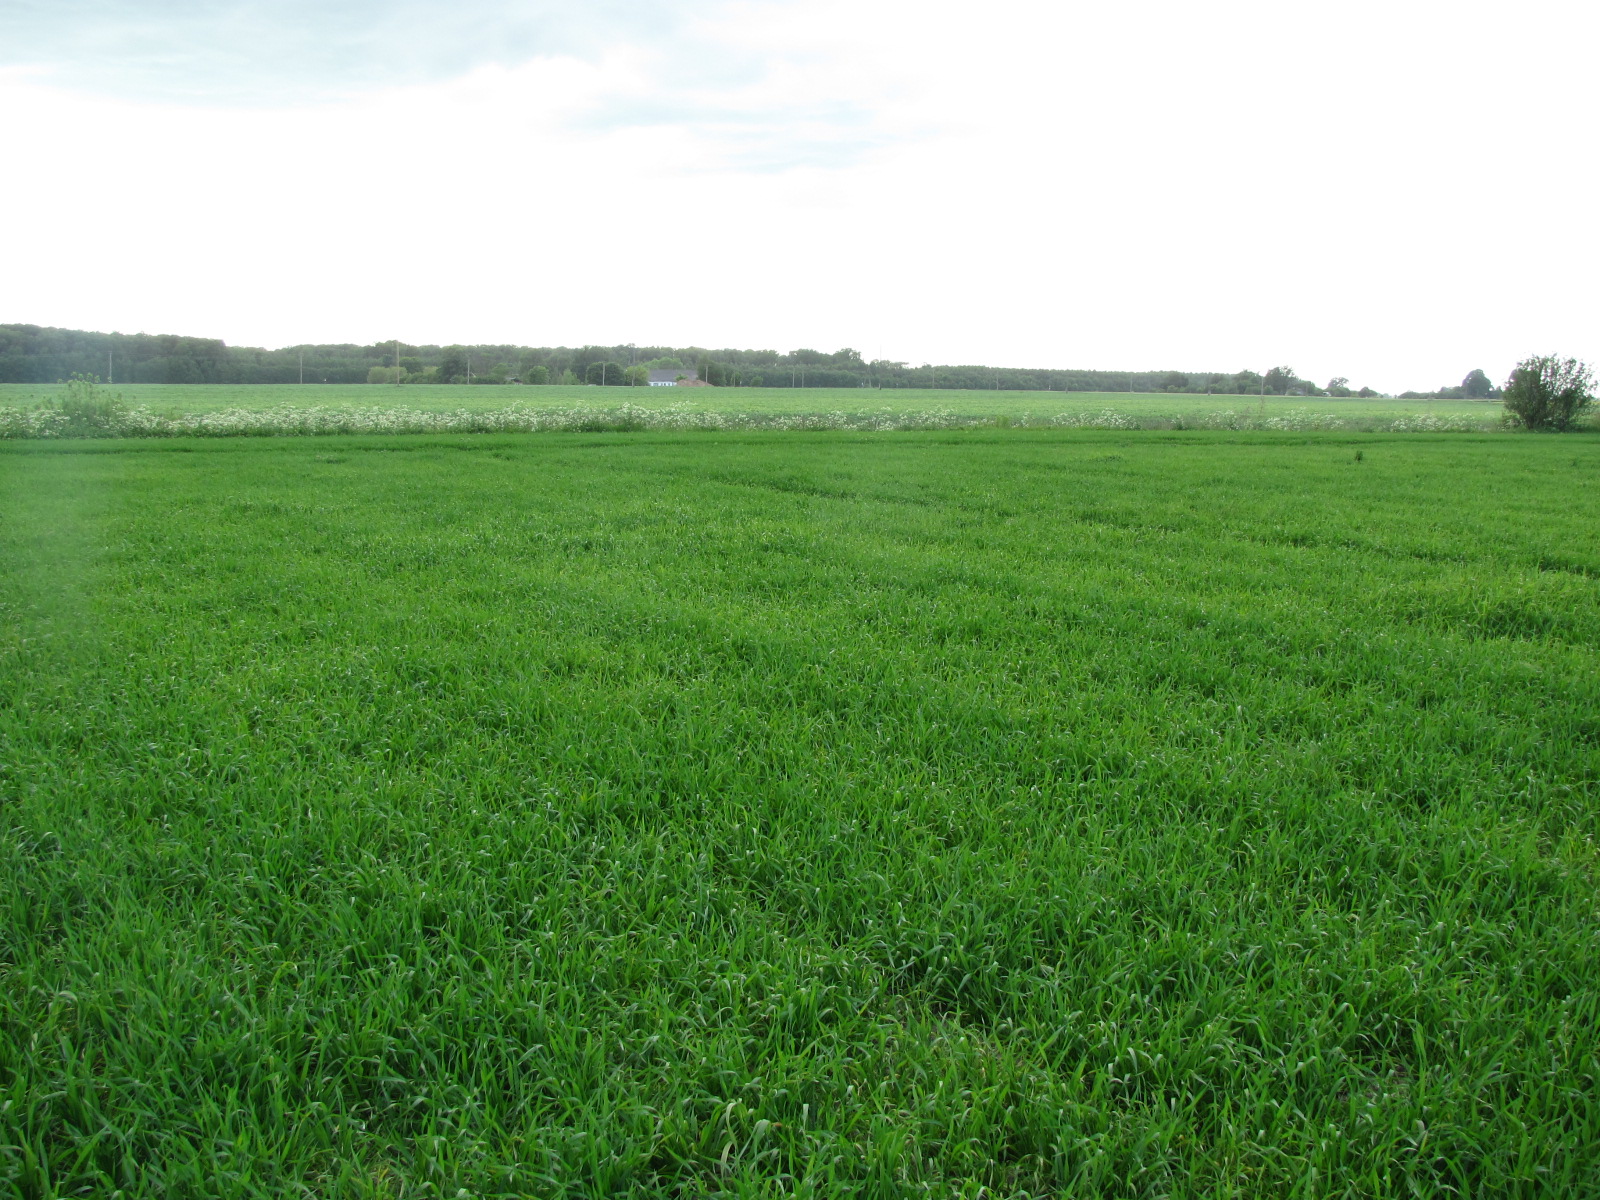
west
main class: Cropland
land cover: Common wheat
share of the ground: > 75 %
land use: Agriculture (excluding fallow land and kitchen gardens)
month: June
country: LV
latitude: 56.3772
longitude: 24.2270
